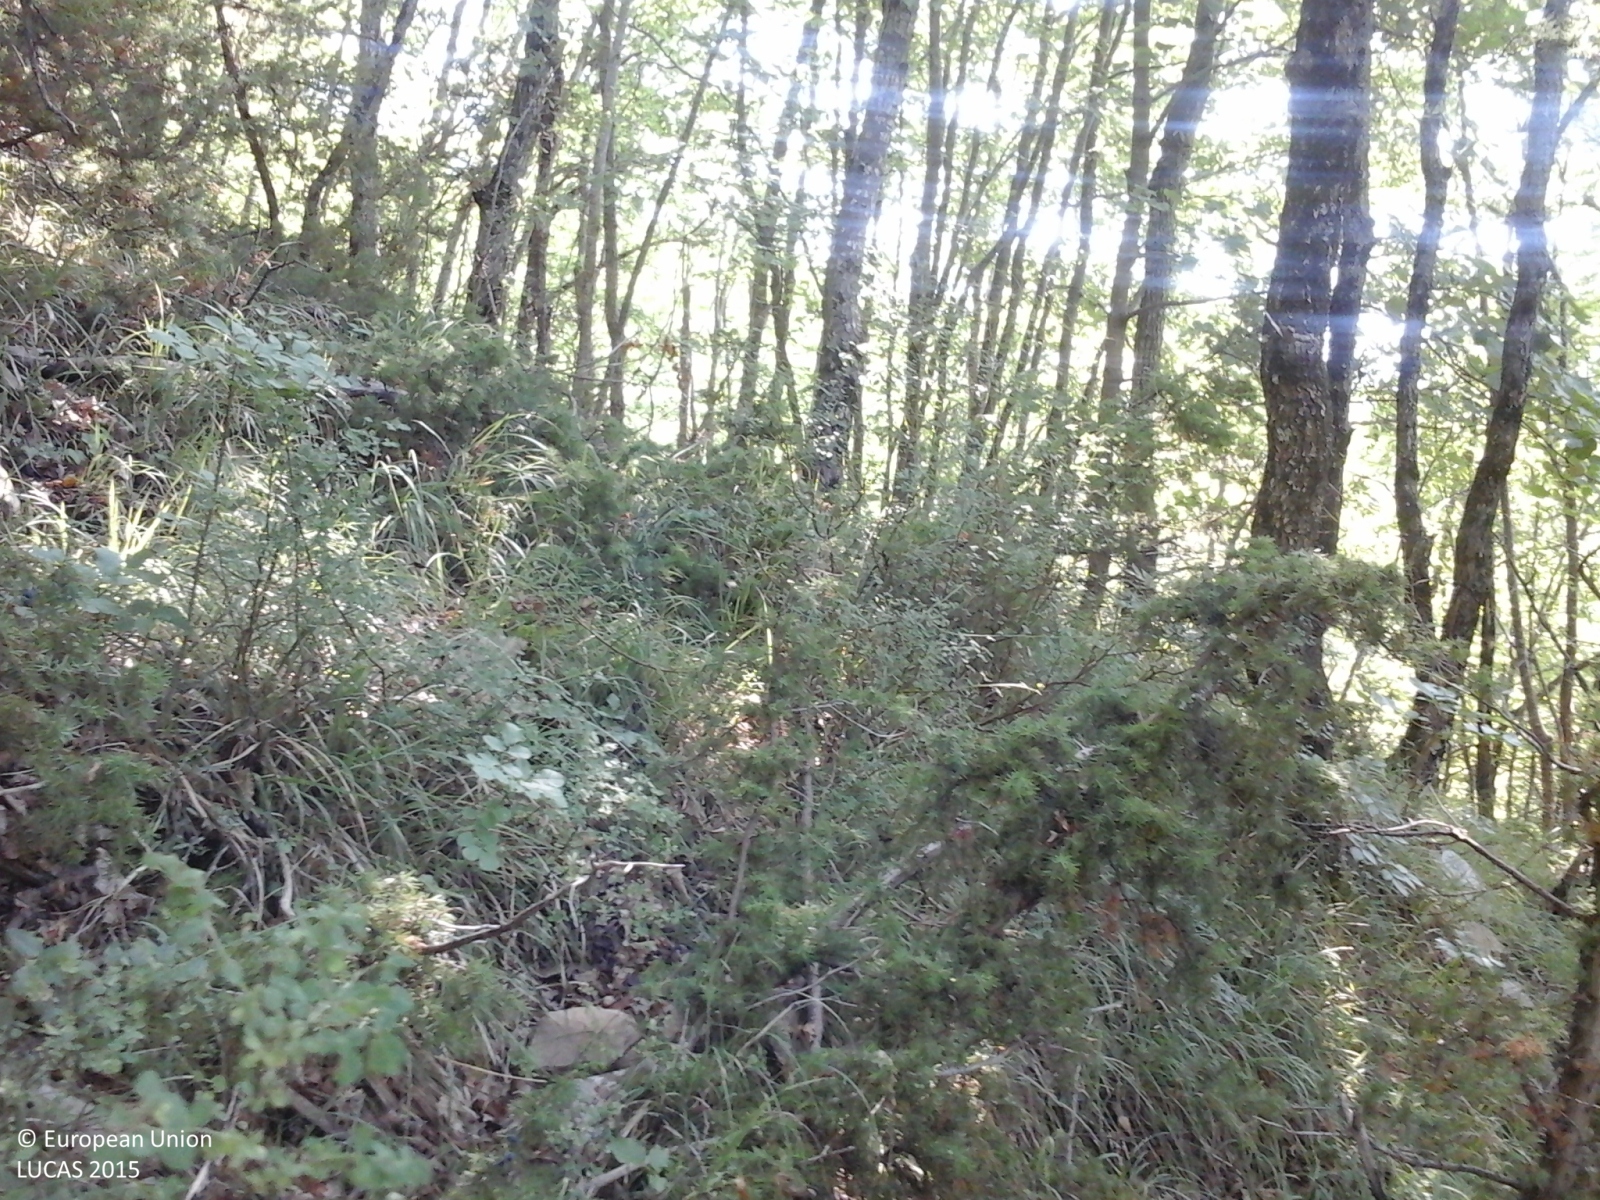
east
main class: Woodland
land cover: Broadleaved woodland
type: thermophilous deciduous forest
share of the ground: > 75 %
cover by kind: broadleaved forest trees 100 %
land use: Forestry
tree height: > 5 m
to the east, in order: Broadleaved woodland; Tracks; Shrubland with sparse tree cover; Broadleaved woodland
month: August
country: IT
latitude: 43.6953
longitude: 12.2153
